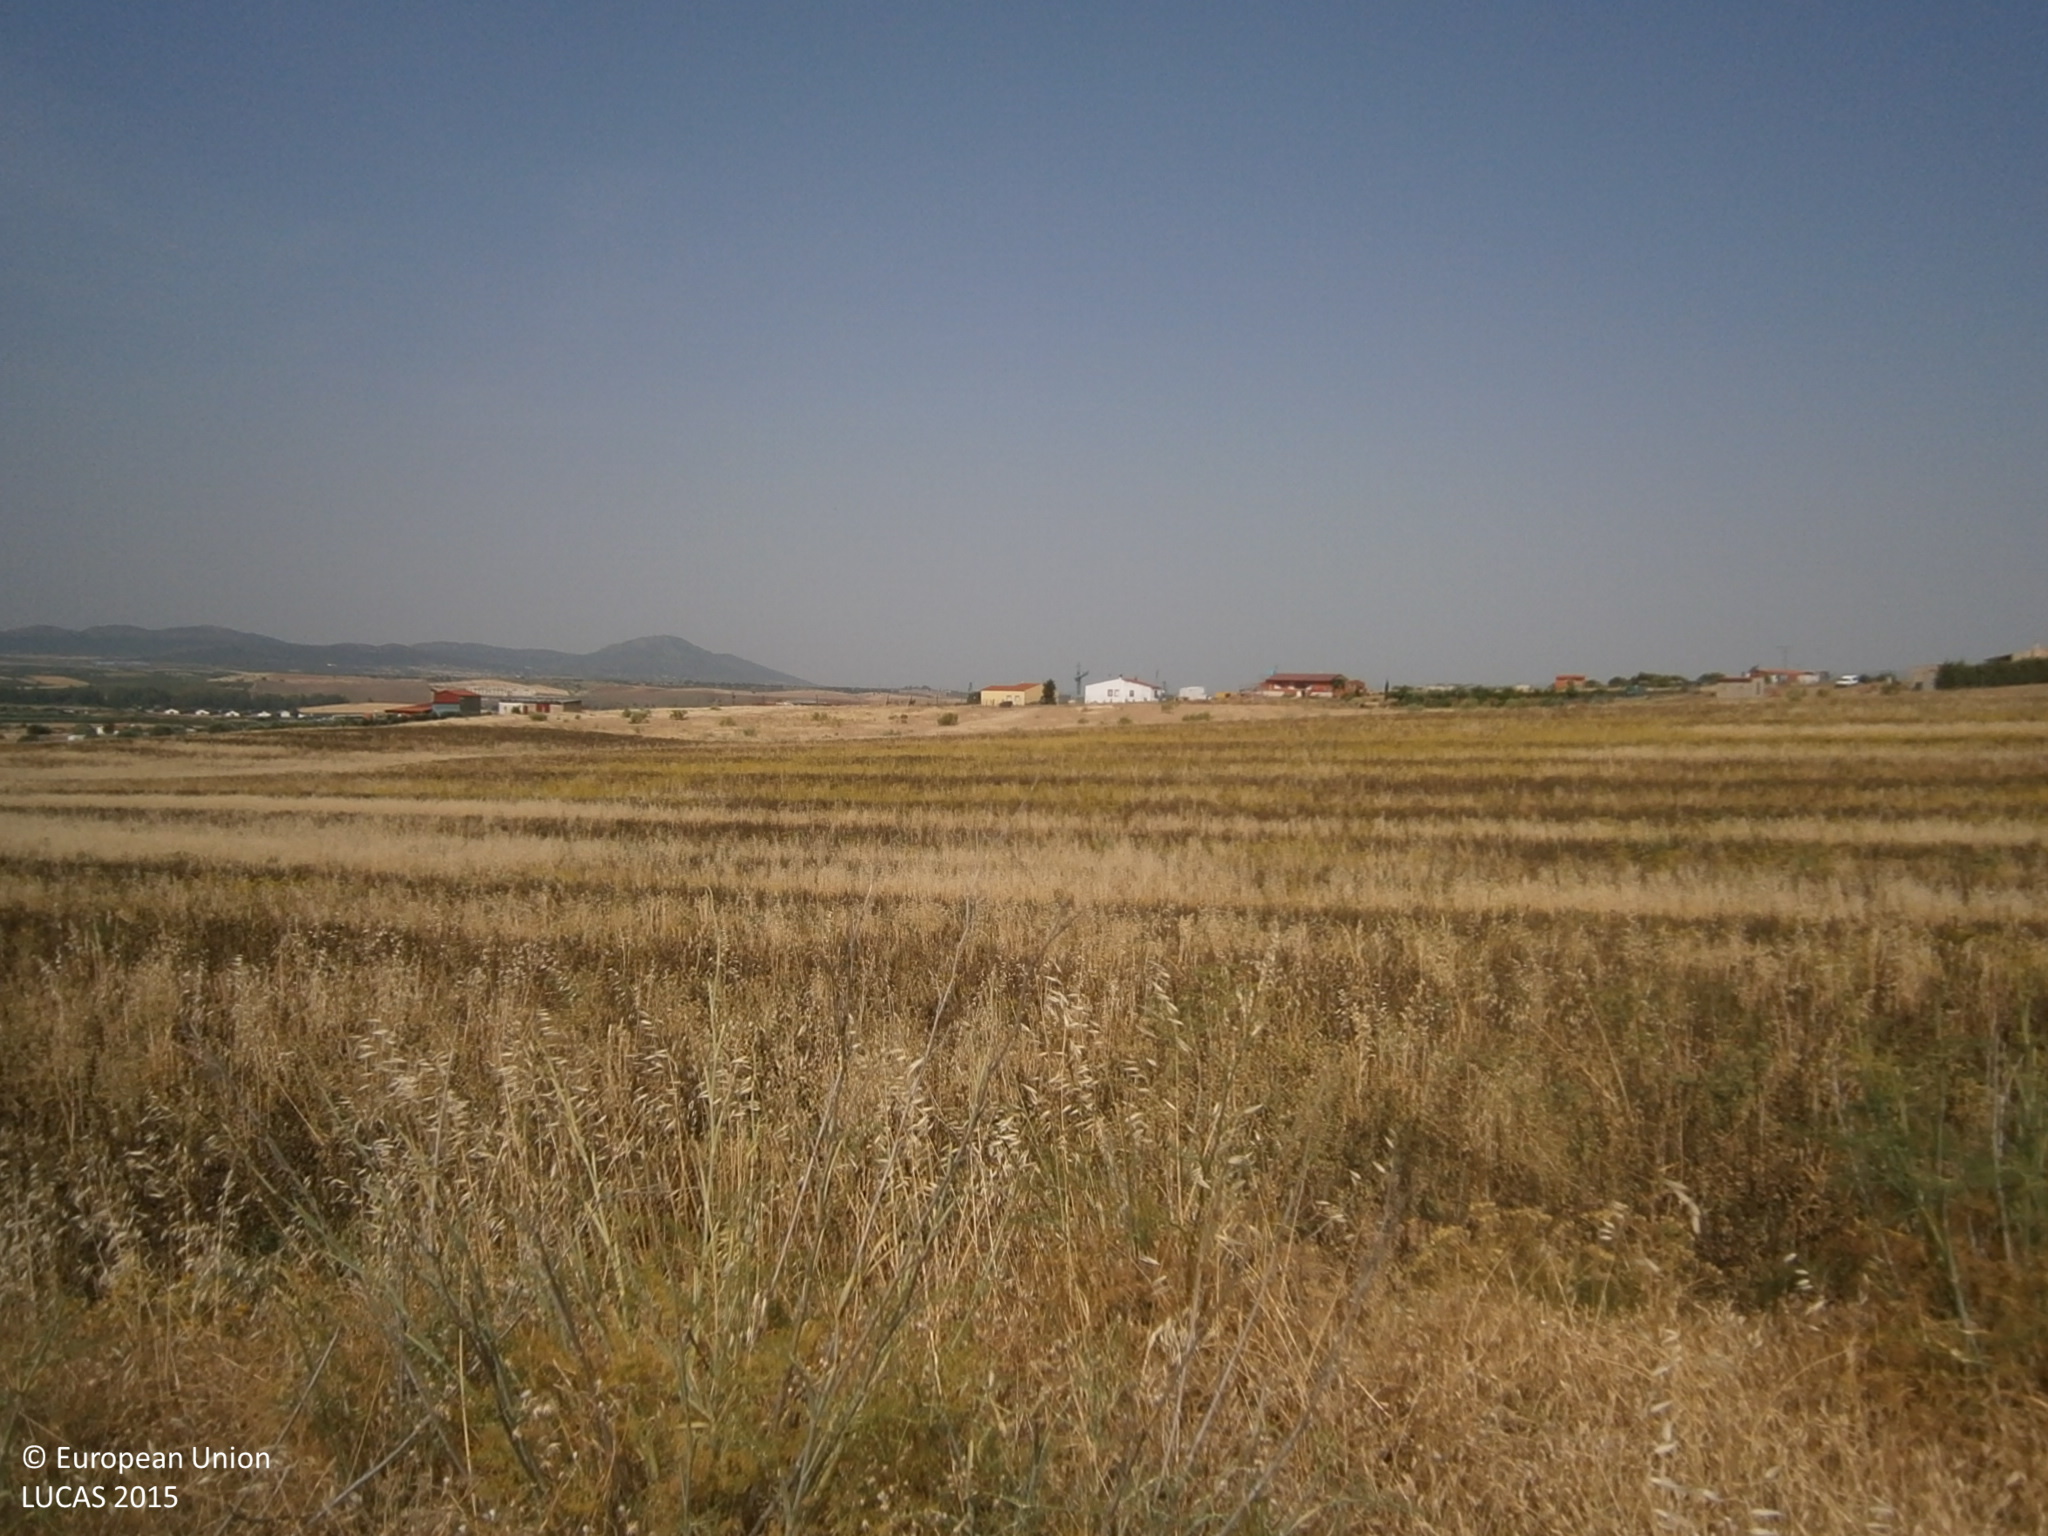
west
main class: Grassland
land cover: Grassland without tree/shrub cover
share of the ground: > 75 %
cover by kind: herbaceous plants 95 %
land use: Agriculture (excluding fallow land and kitchen gardens)
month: June
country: ES
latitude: 38.8936
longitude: -6.3014
